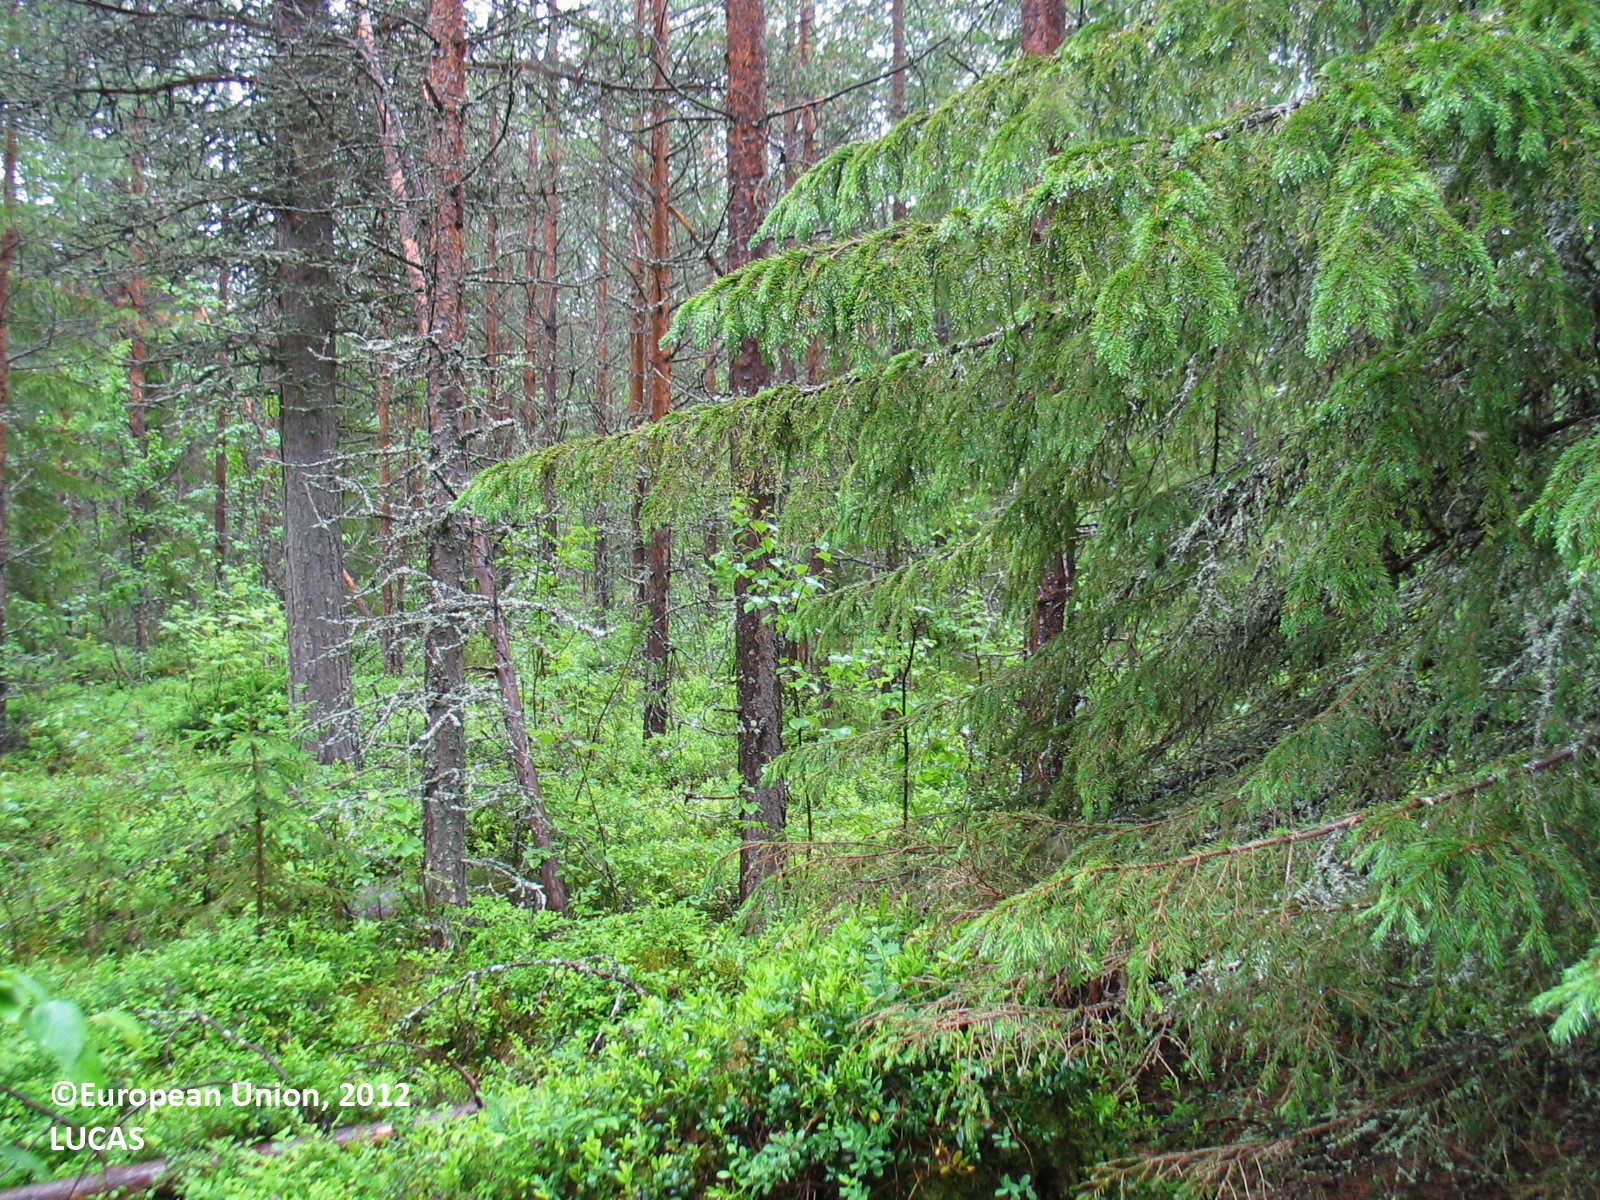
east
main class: Woodland
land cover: Pine dominated coniferous woodland
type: boreal forest
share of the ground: 25 - 50 %
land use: Forestry
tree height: > 5 m
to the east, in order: Pine dominated coniferous woodland; Other mixed woodland; Pine dominated coniferous woodland; Other mixed woodland; Ditches and canals; Other mixed woodland
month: July
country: FI
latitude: 66.0384
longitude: 24.8639
